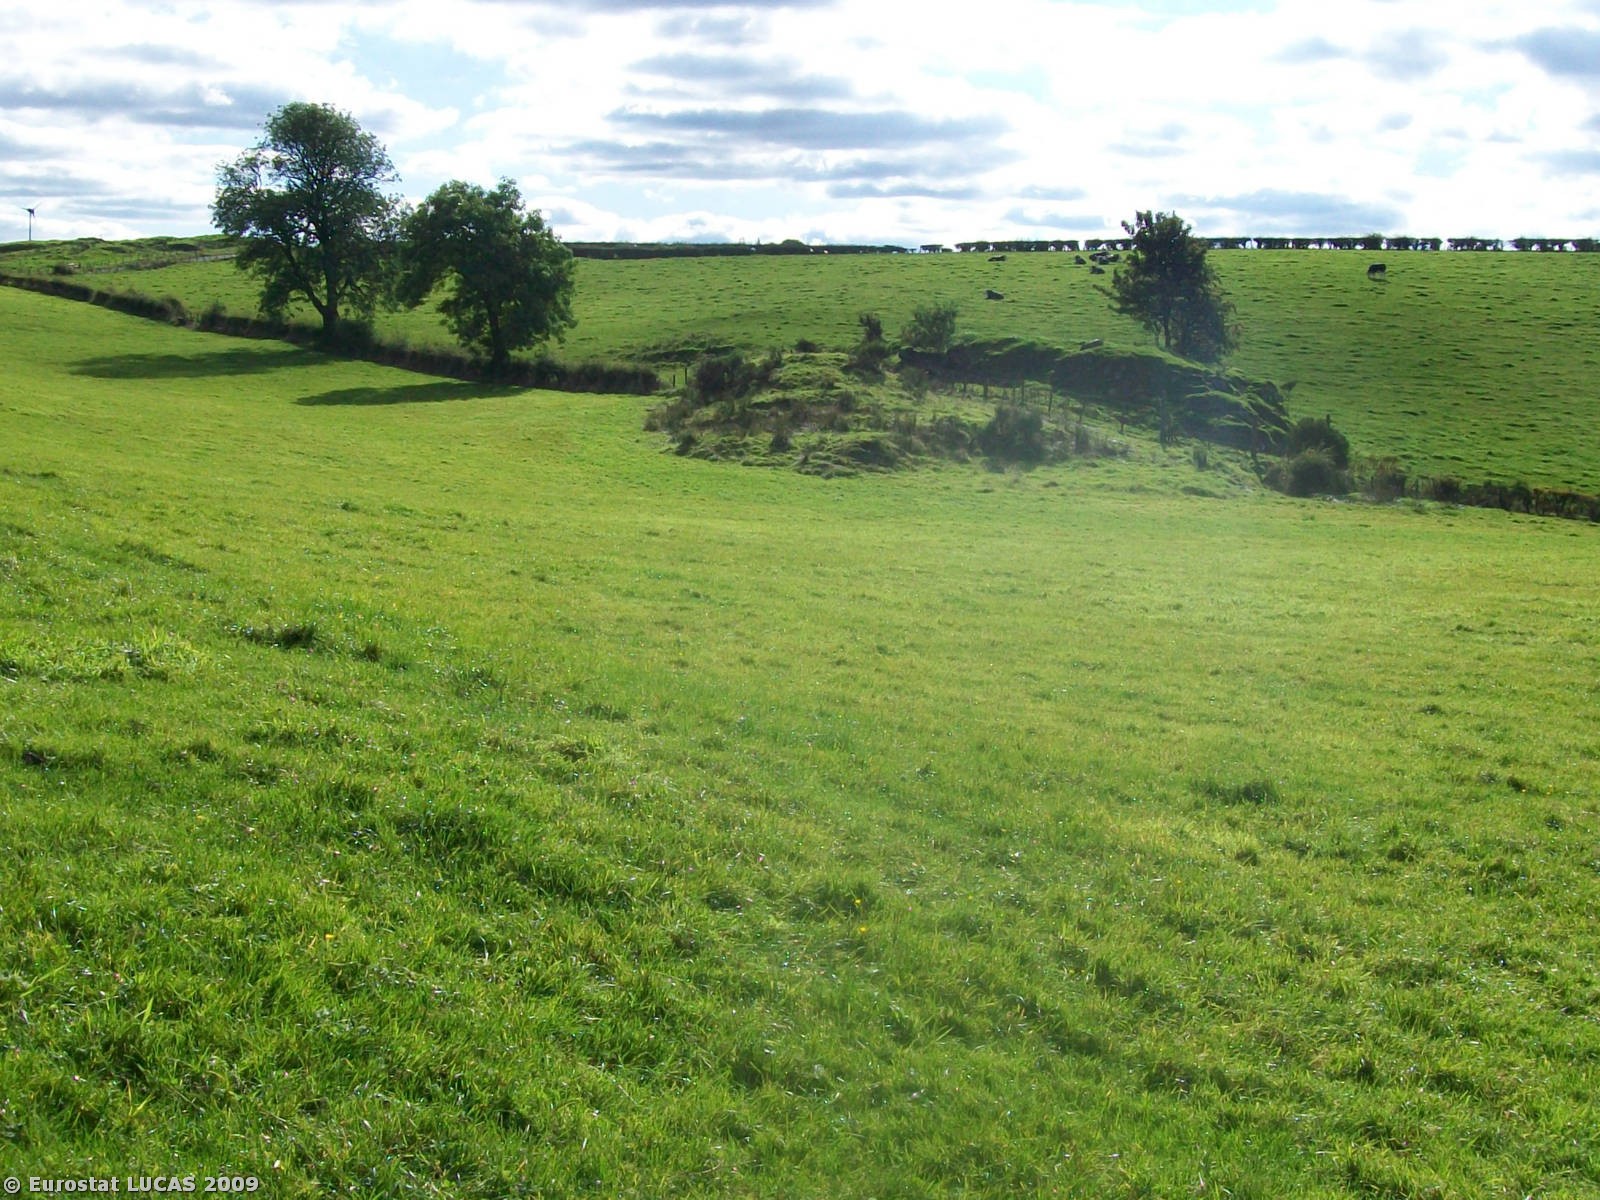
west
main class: Grassland
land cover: Grassland without tree/shrub cover
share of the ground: < 10 %
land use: Agriculture (excluding fallow land and kitchen gardens)
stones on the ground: 10 - 25 %
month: September
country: GB
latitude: 55.7761
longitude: -4.3646
